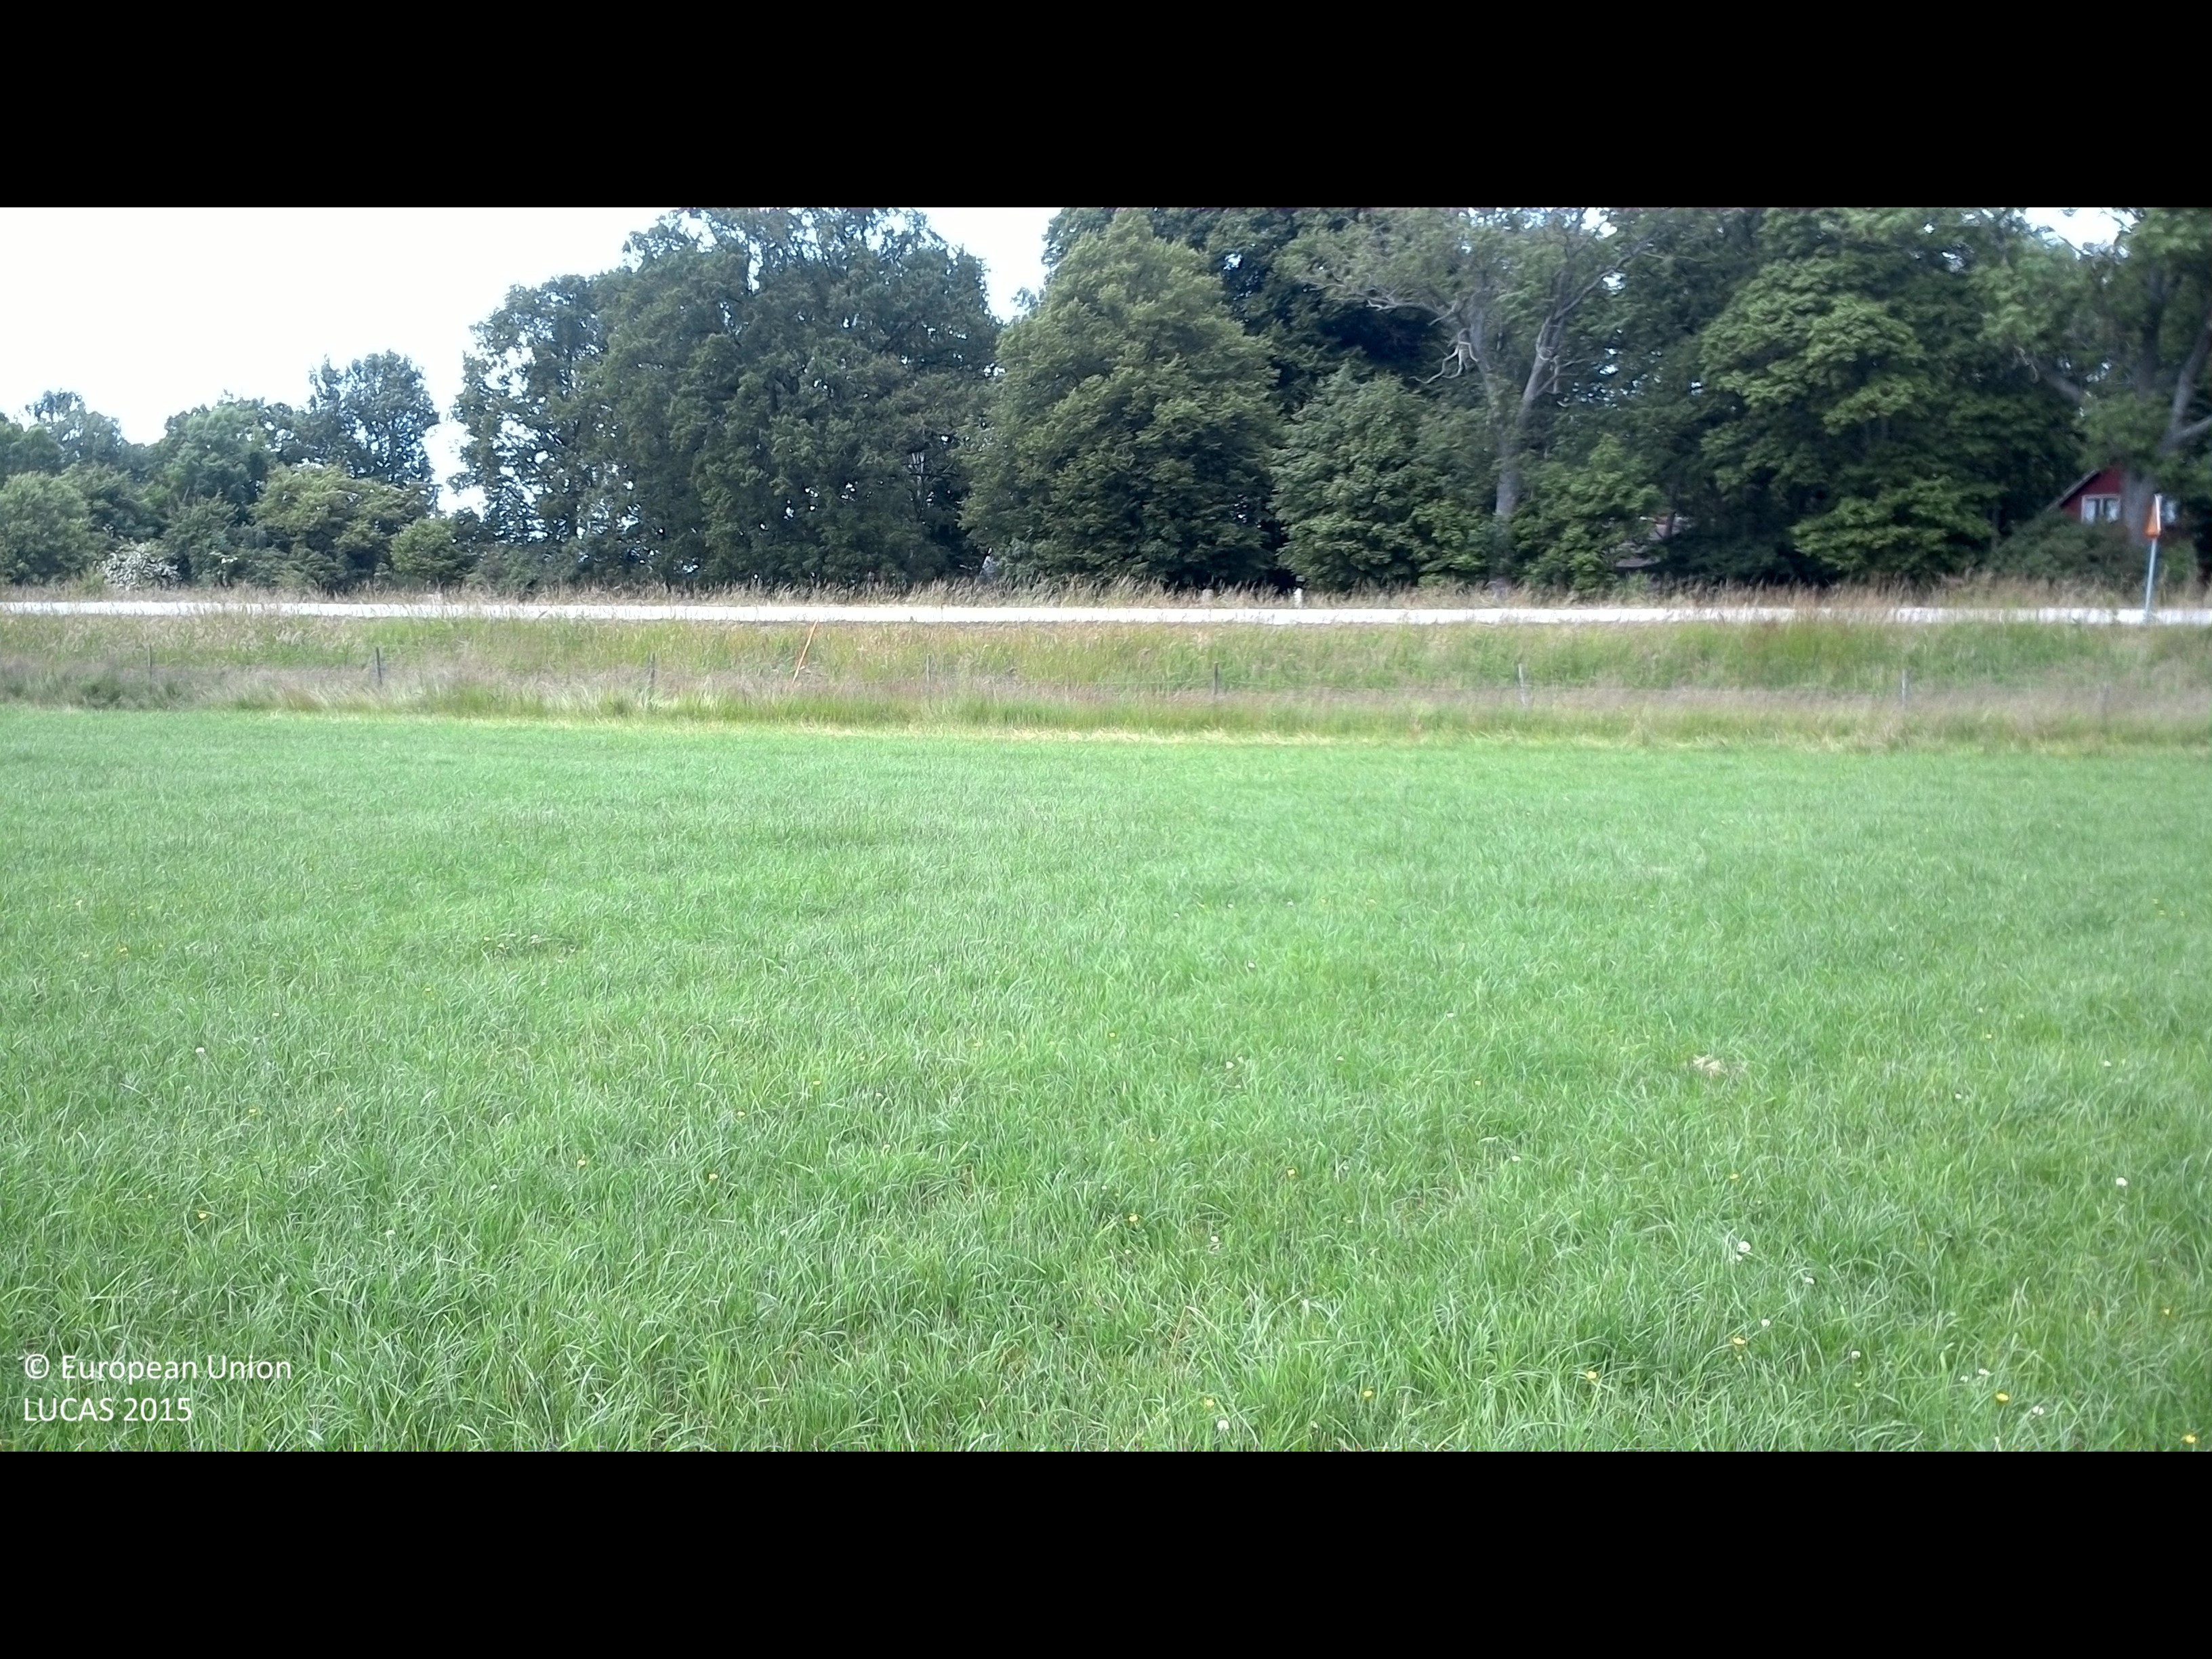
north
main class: Cropland
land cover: Temporary grasslands
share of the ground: > 75 %
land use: Agriculture (excluding fallow land and kitchen gardens)
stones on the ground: < 10 %
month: June
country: SE
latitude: 56.4403
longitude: 16.0830
